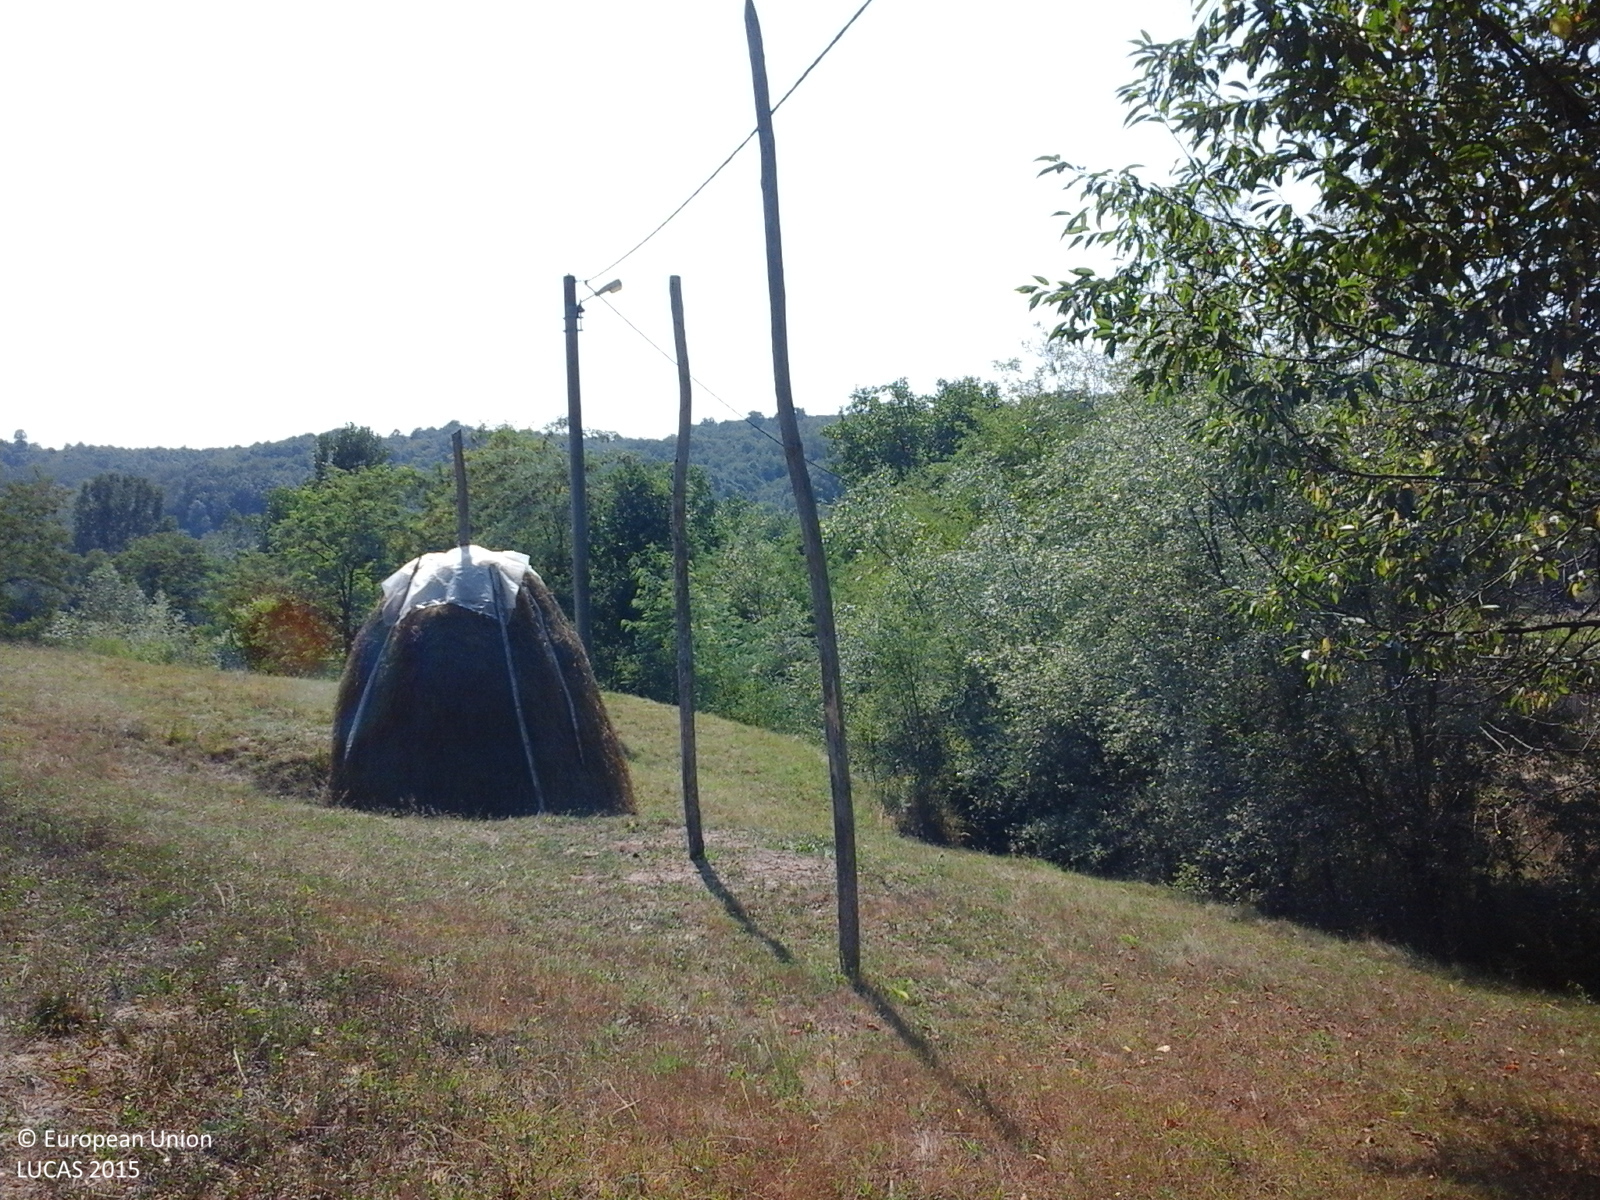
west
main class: Grassland
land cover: Grassland without tree/shrub cover
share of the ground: 50 - 75 %
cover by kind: herbaceous plants 100 %
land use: Agriculture (excluding fallow land and kitchen gardens)
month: July
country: RO
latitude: 44.8713
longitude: 24.4395
